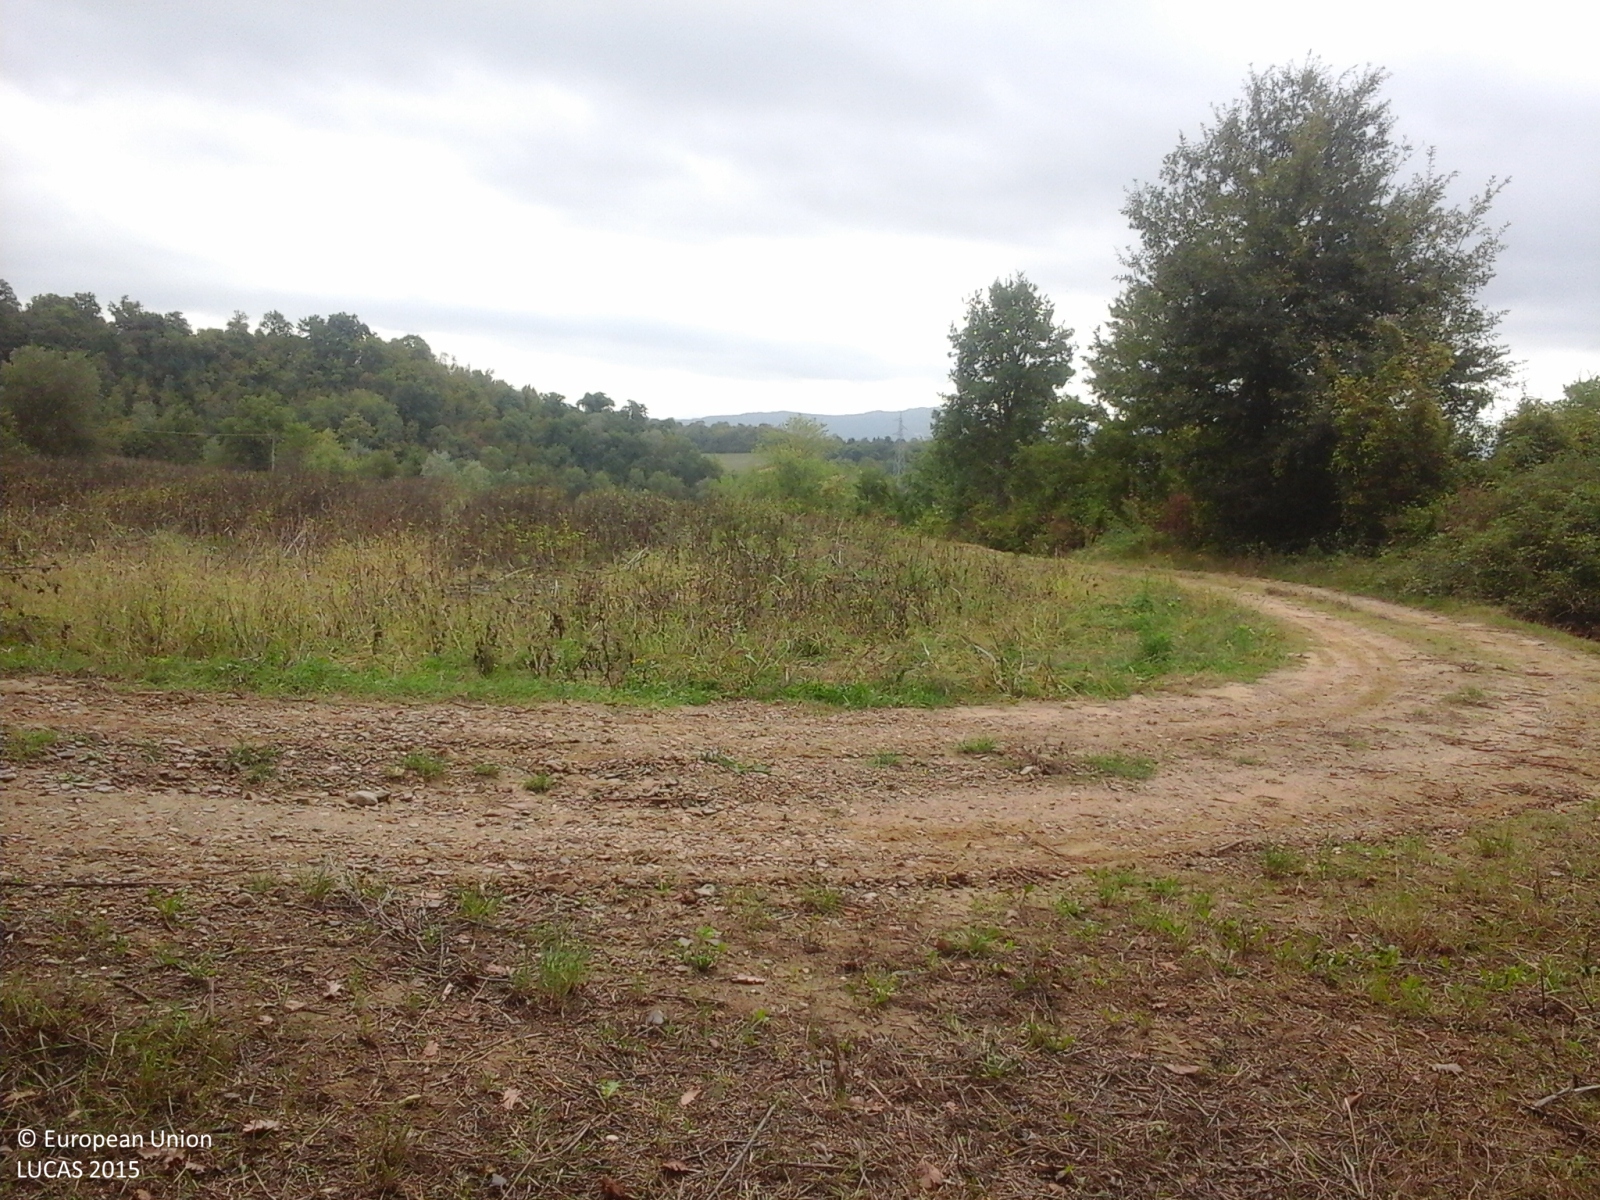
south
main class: Woodland
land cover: Broadleaved woodland
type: thermophilous deciduous forest
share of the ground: > 75 %
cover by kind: broadleaved forest trees 90 %, shrubs 10 %
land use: Forestry
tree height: > 5 m
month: October
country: IT
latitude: 43.4051
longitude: 12.2782
